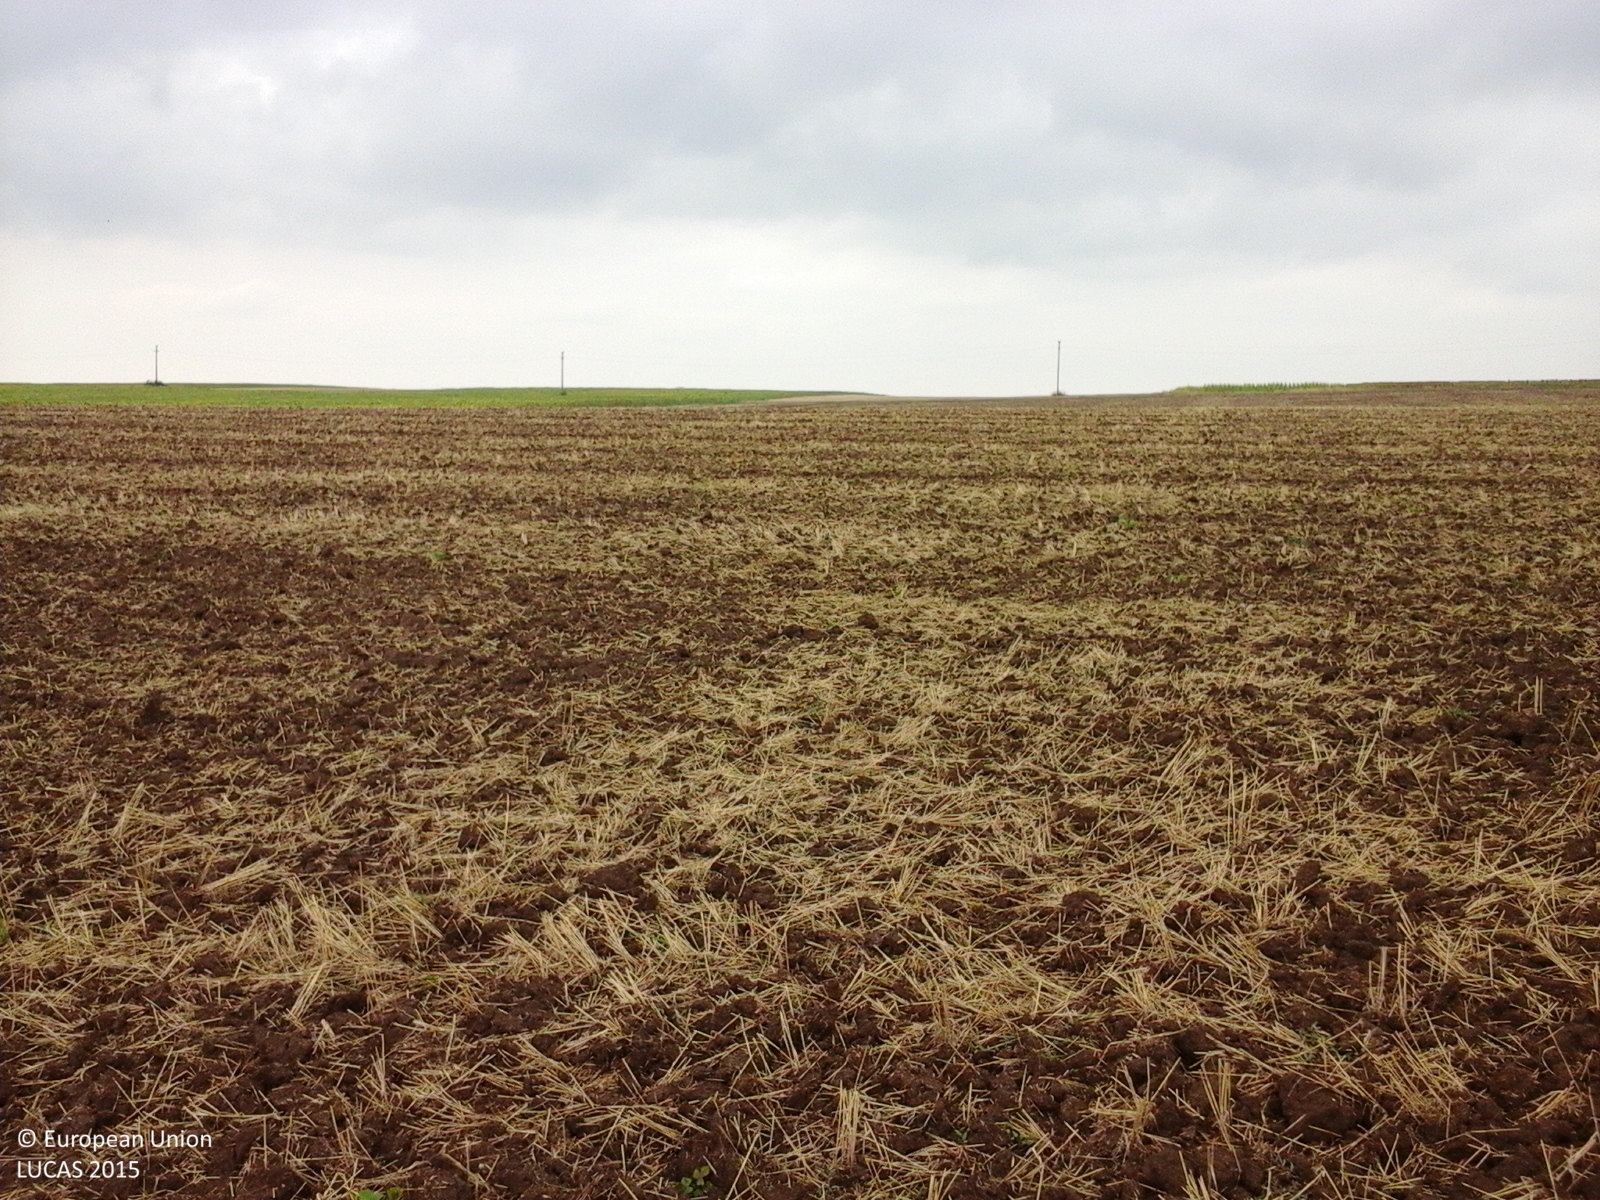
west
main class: Cropland
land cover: Common wheat
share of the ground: 25 - 50 %
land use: Agriculture (excluding fallow land and kitchen gardens)
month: August
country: RO
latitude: 45.9303
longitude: 21.3168
